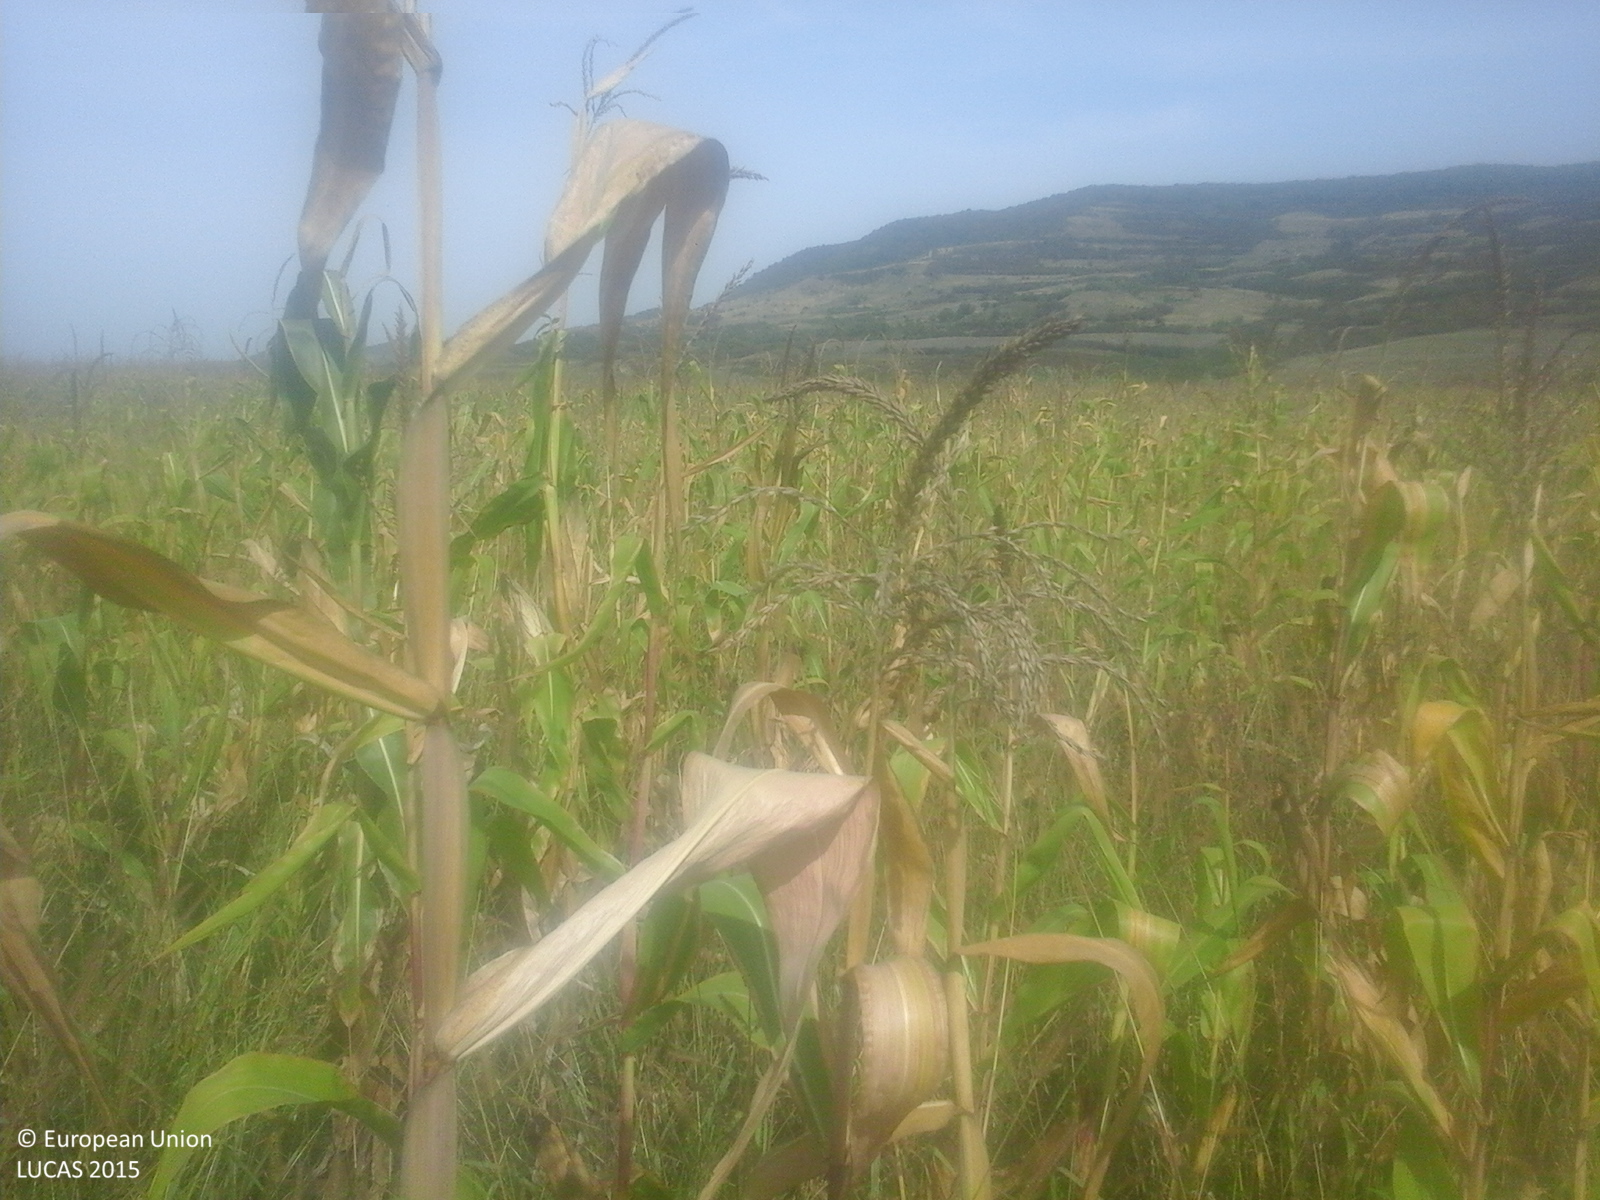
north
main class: Cropland
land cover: Maize
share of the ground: > 75 %
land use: Agriculture (excluding fallow land and kitchen gardens)
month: September
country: RO
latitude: 47.0421
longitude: 24.3410
